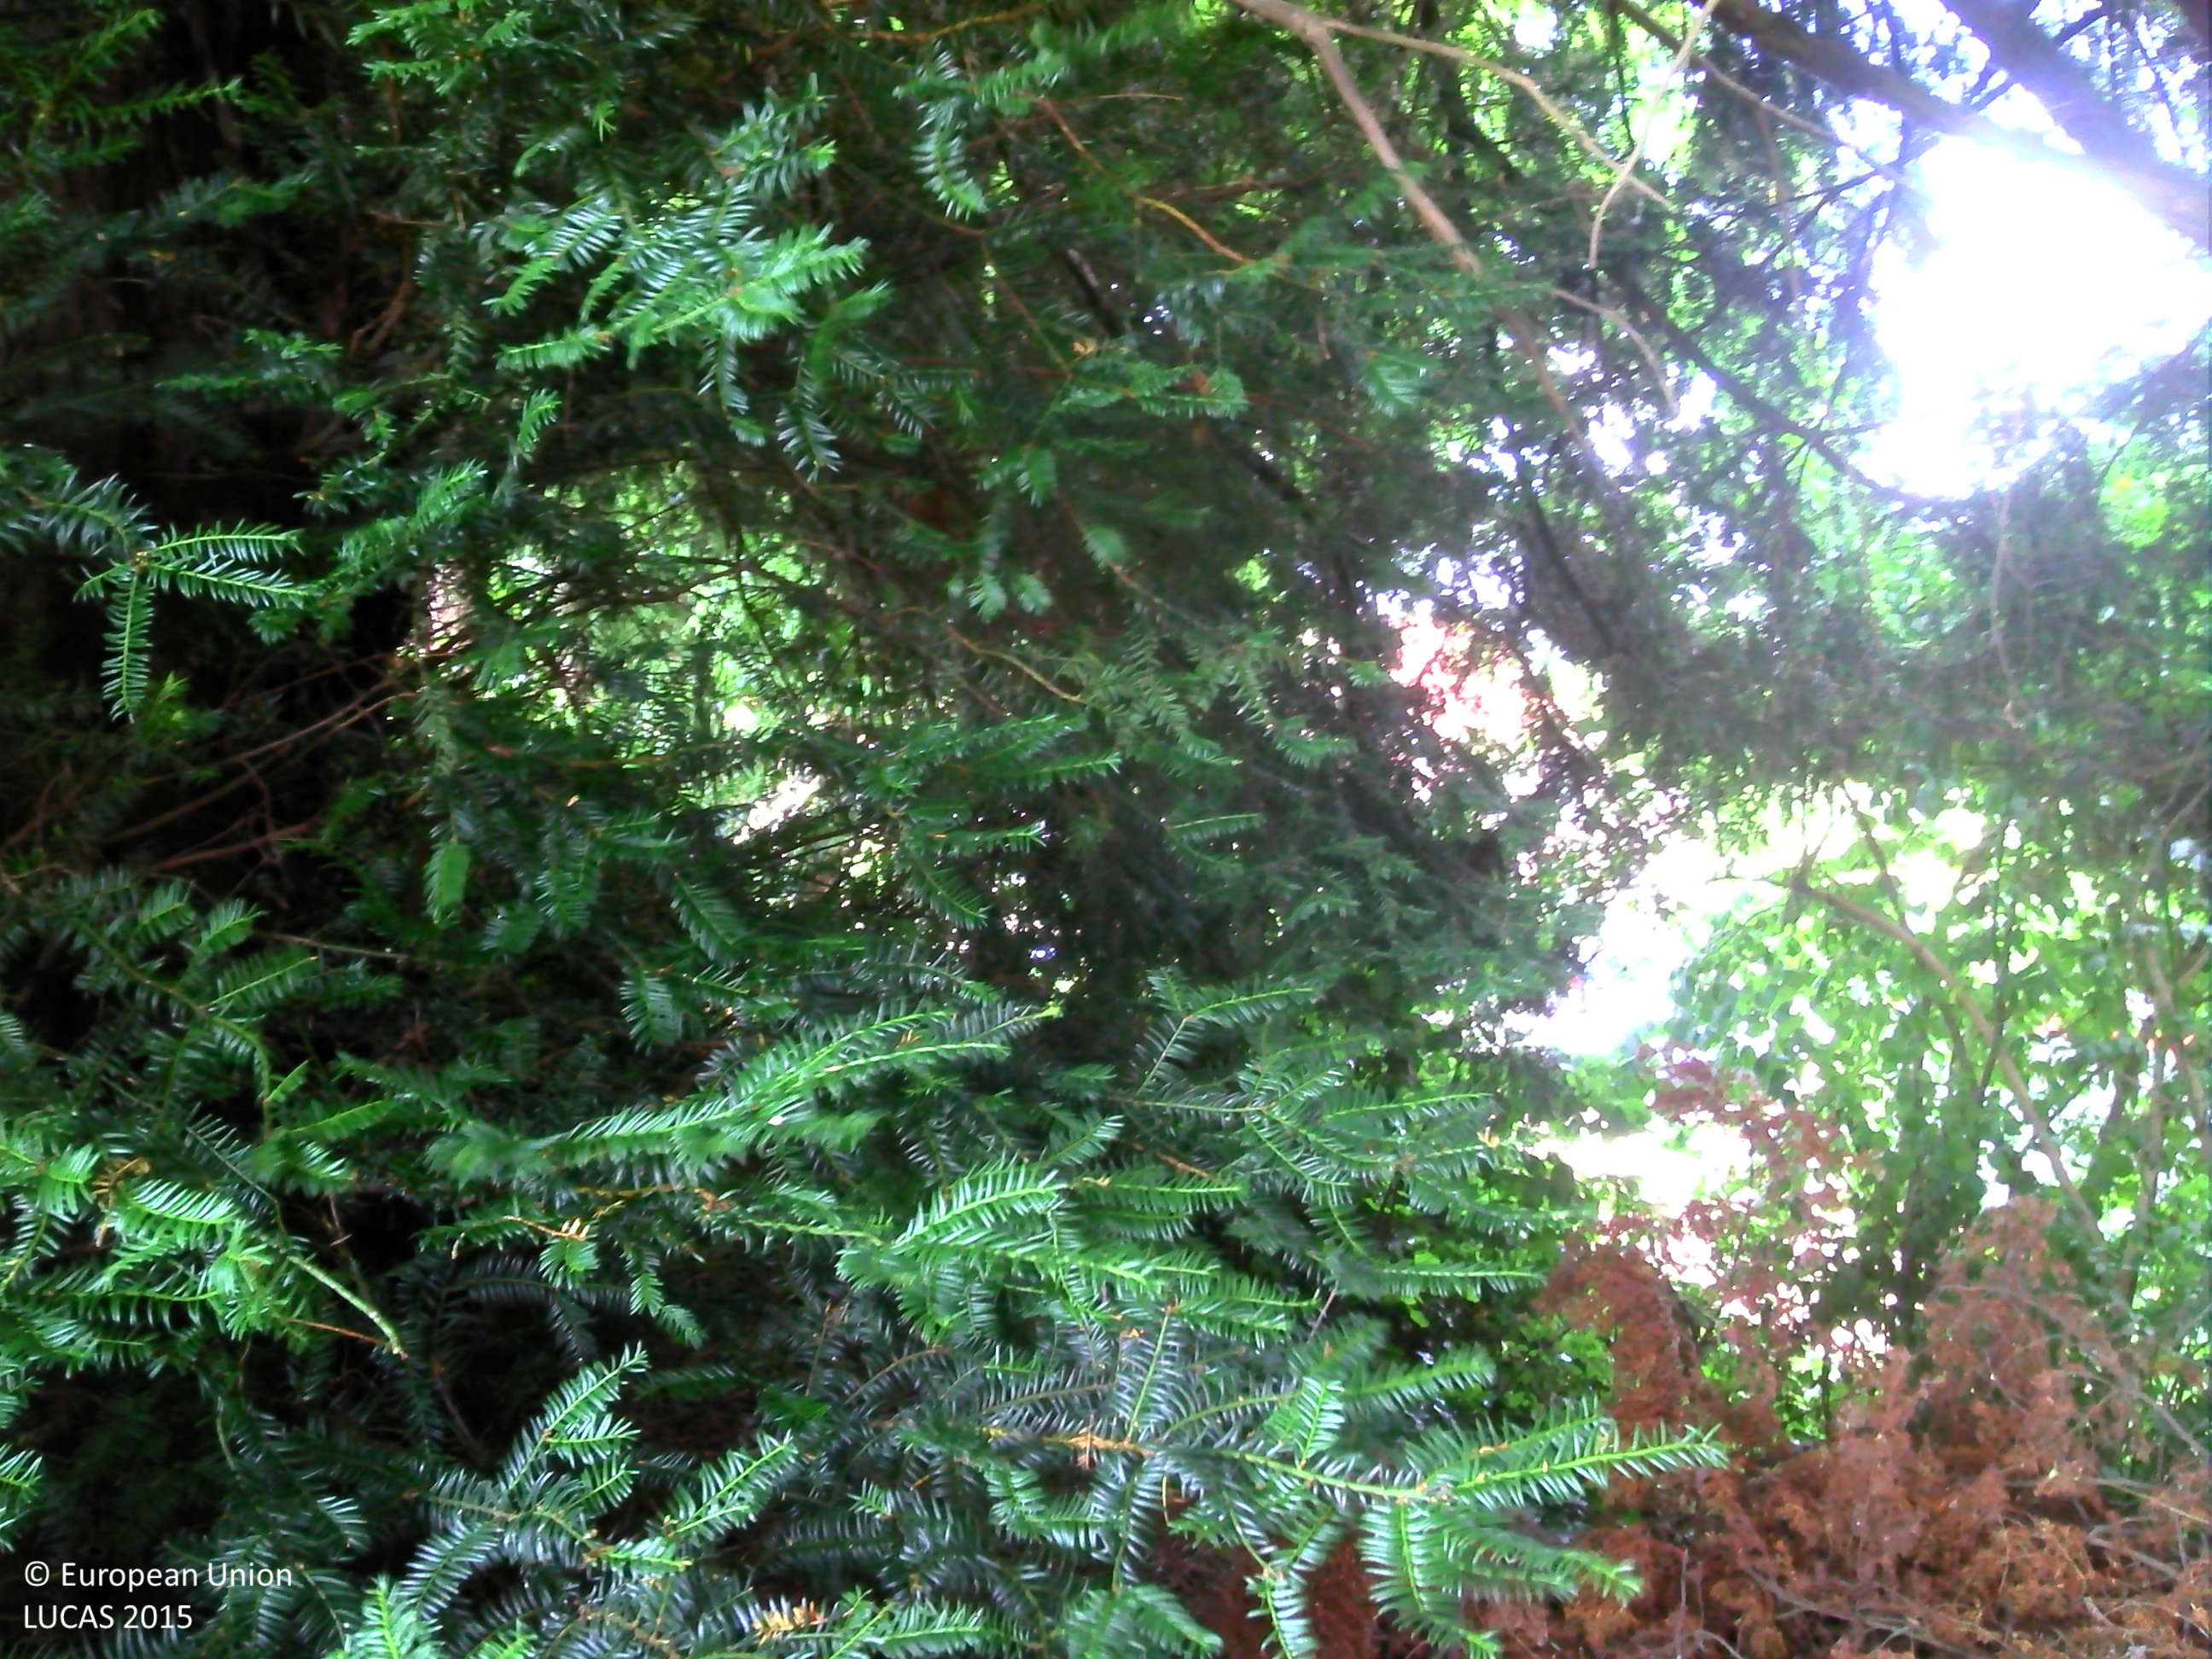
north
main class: Woodland
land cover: Spruce dominated mixed woodland
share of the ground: > 75 %
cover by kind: coniferous forest trees 75 %, broadleaved forest trees 25 %
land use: Residential
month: July
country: BE
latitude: 50.7708
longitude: 5.2759
